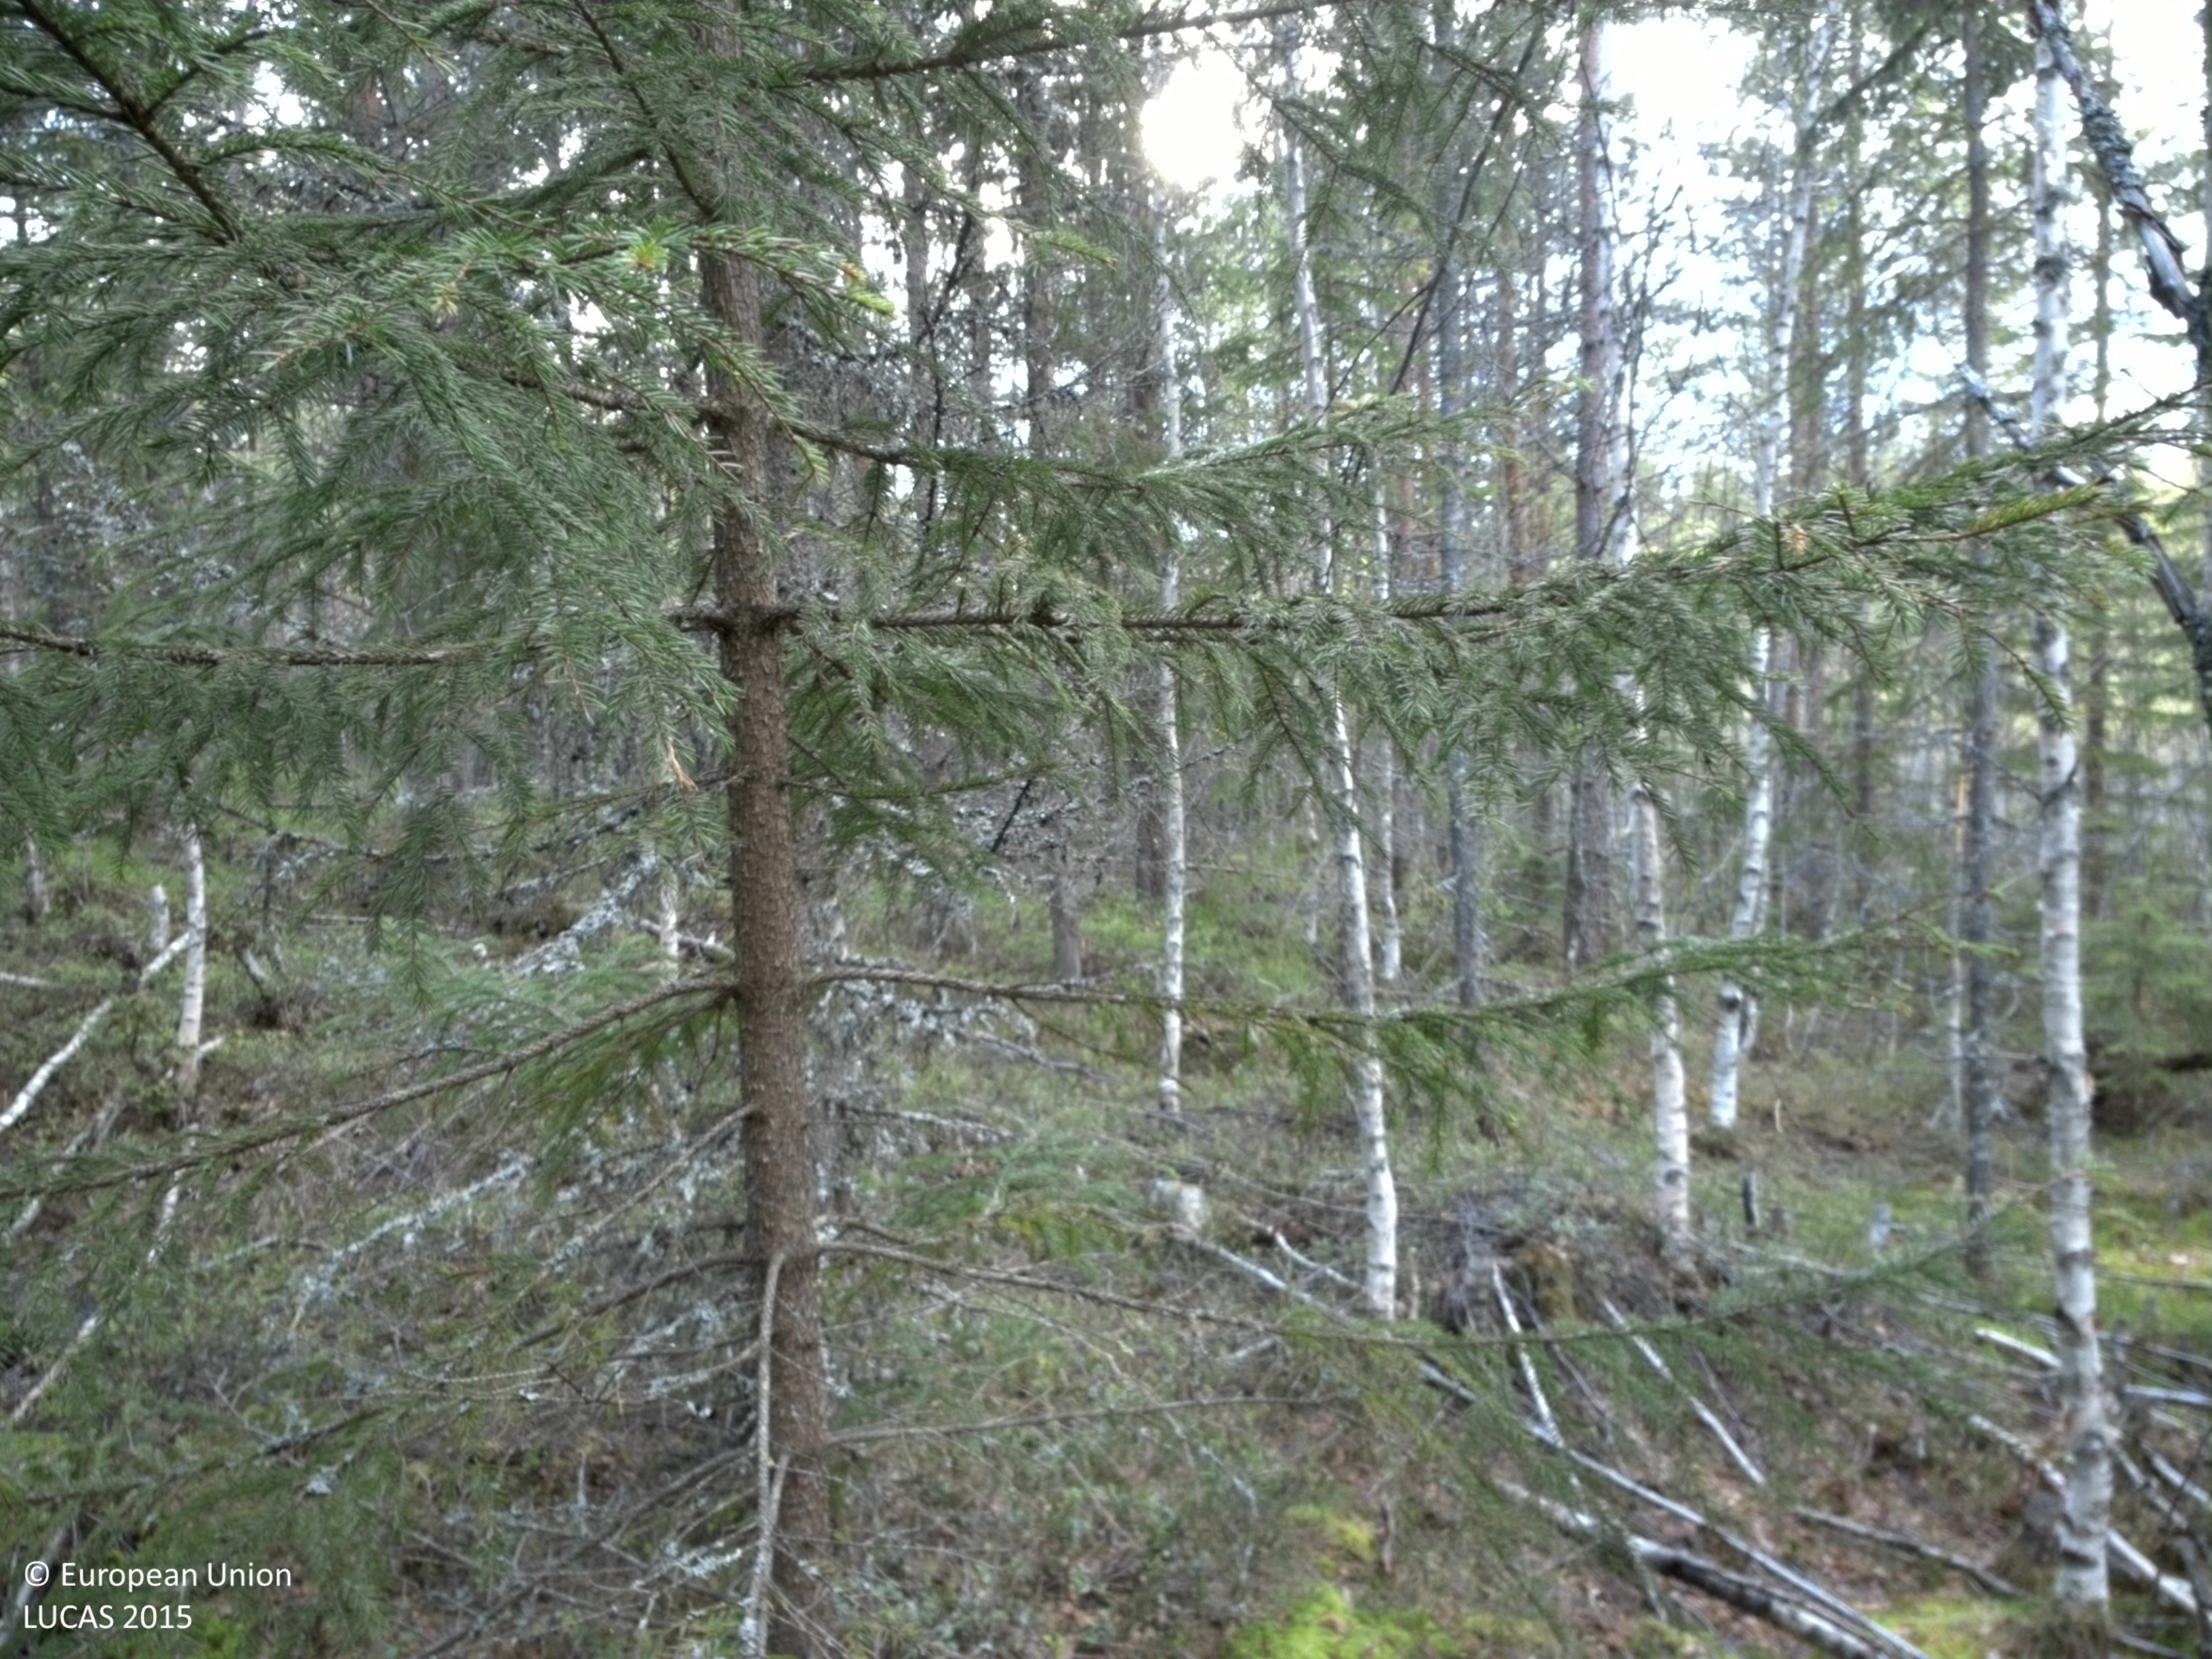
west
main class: Woodland
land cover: Other mixed woodland
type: boreal forest
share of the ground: > 75 %
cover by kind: coniferous forest trees 55 %, broadleaved forest trees 30 %, shrubs 15 %
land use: Forestry
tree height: > 5 m
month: May
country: SE
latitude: 60.3735
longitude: 13.4177
